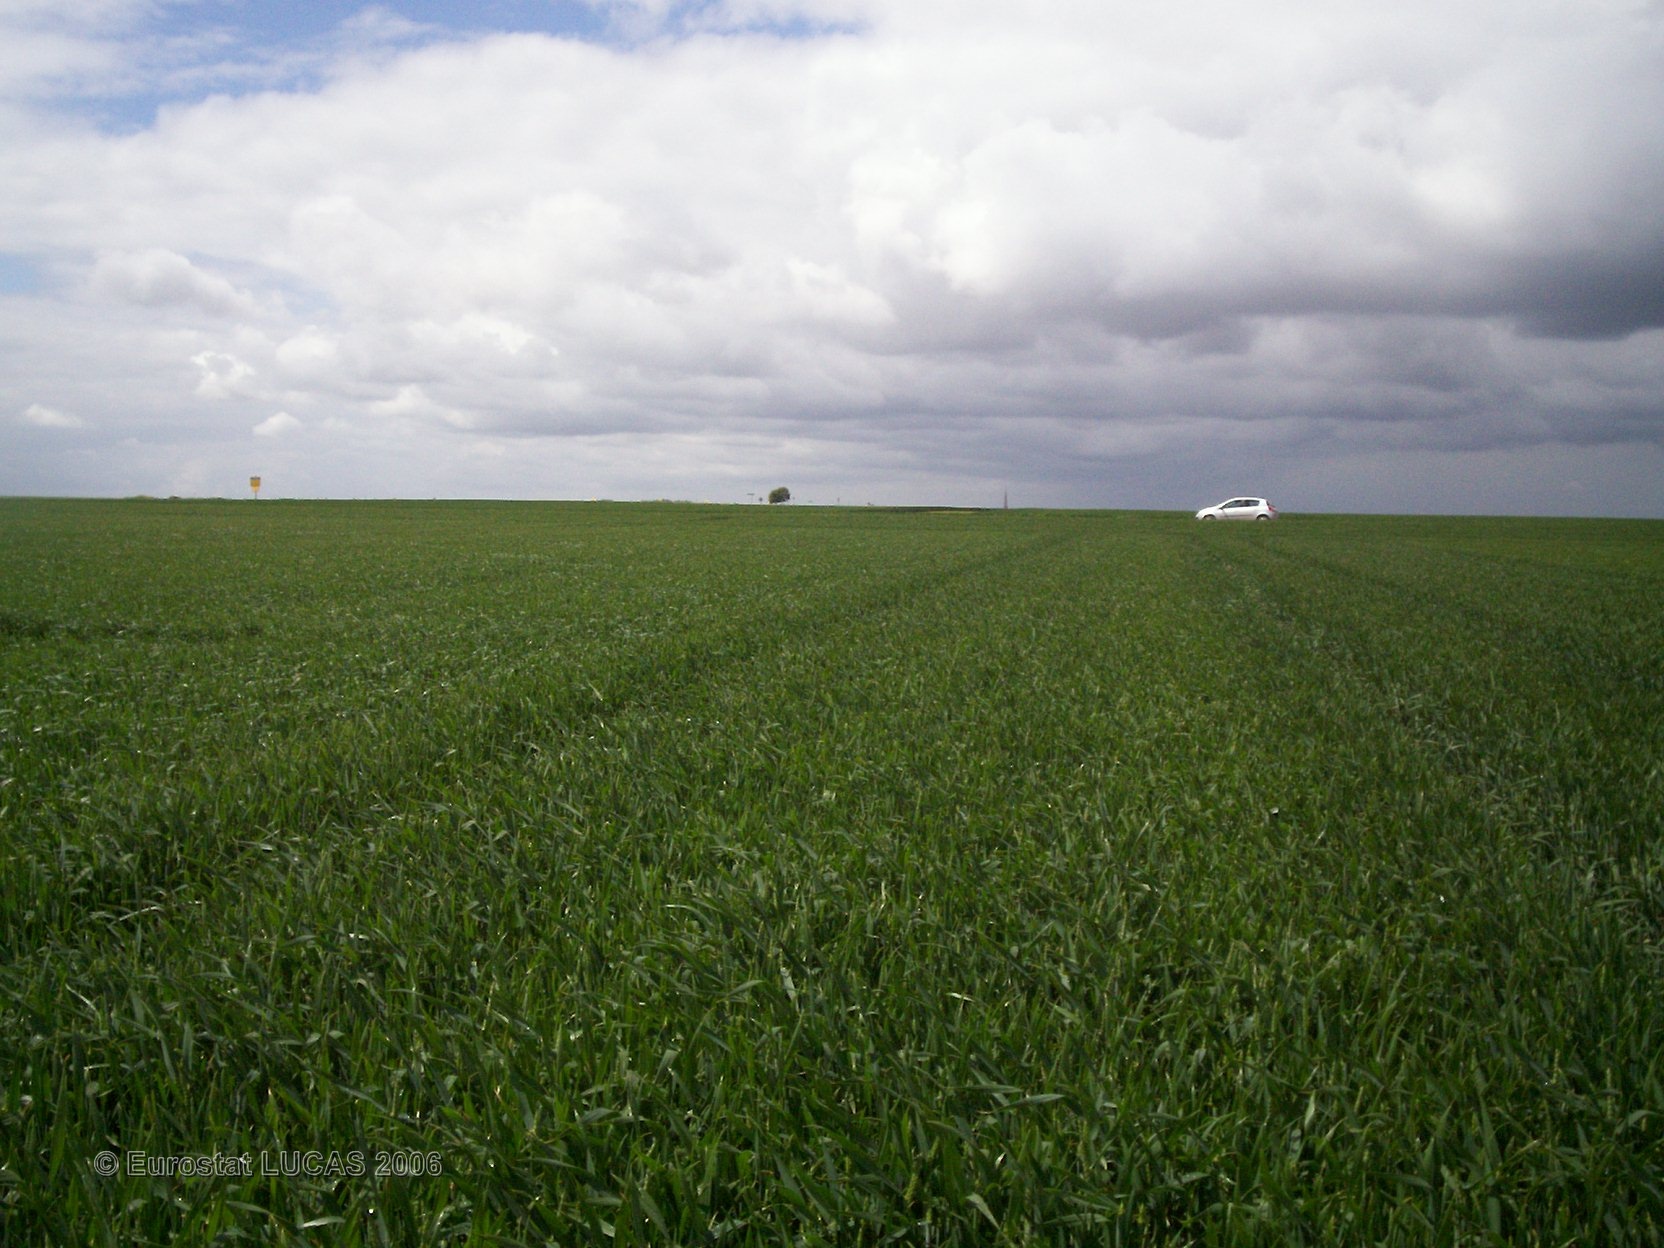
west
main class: Cropland
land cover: Common wheat
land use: Agriculture (excluding fallow land and kitchen gardens)
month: May
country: FR
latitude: 49.8732
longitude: 2.6277
